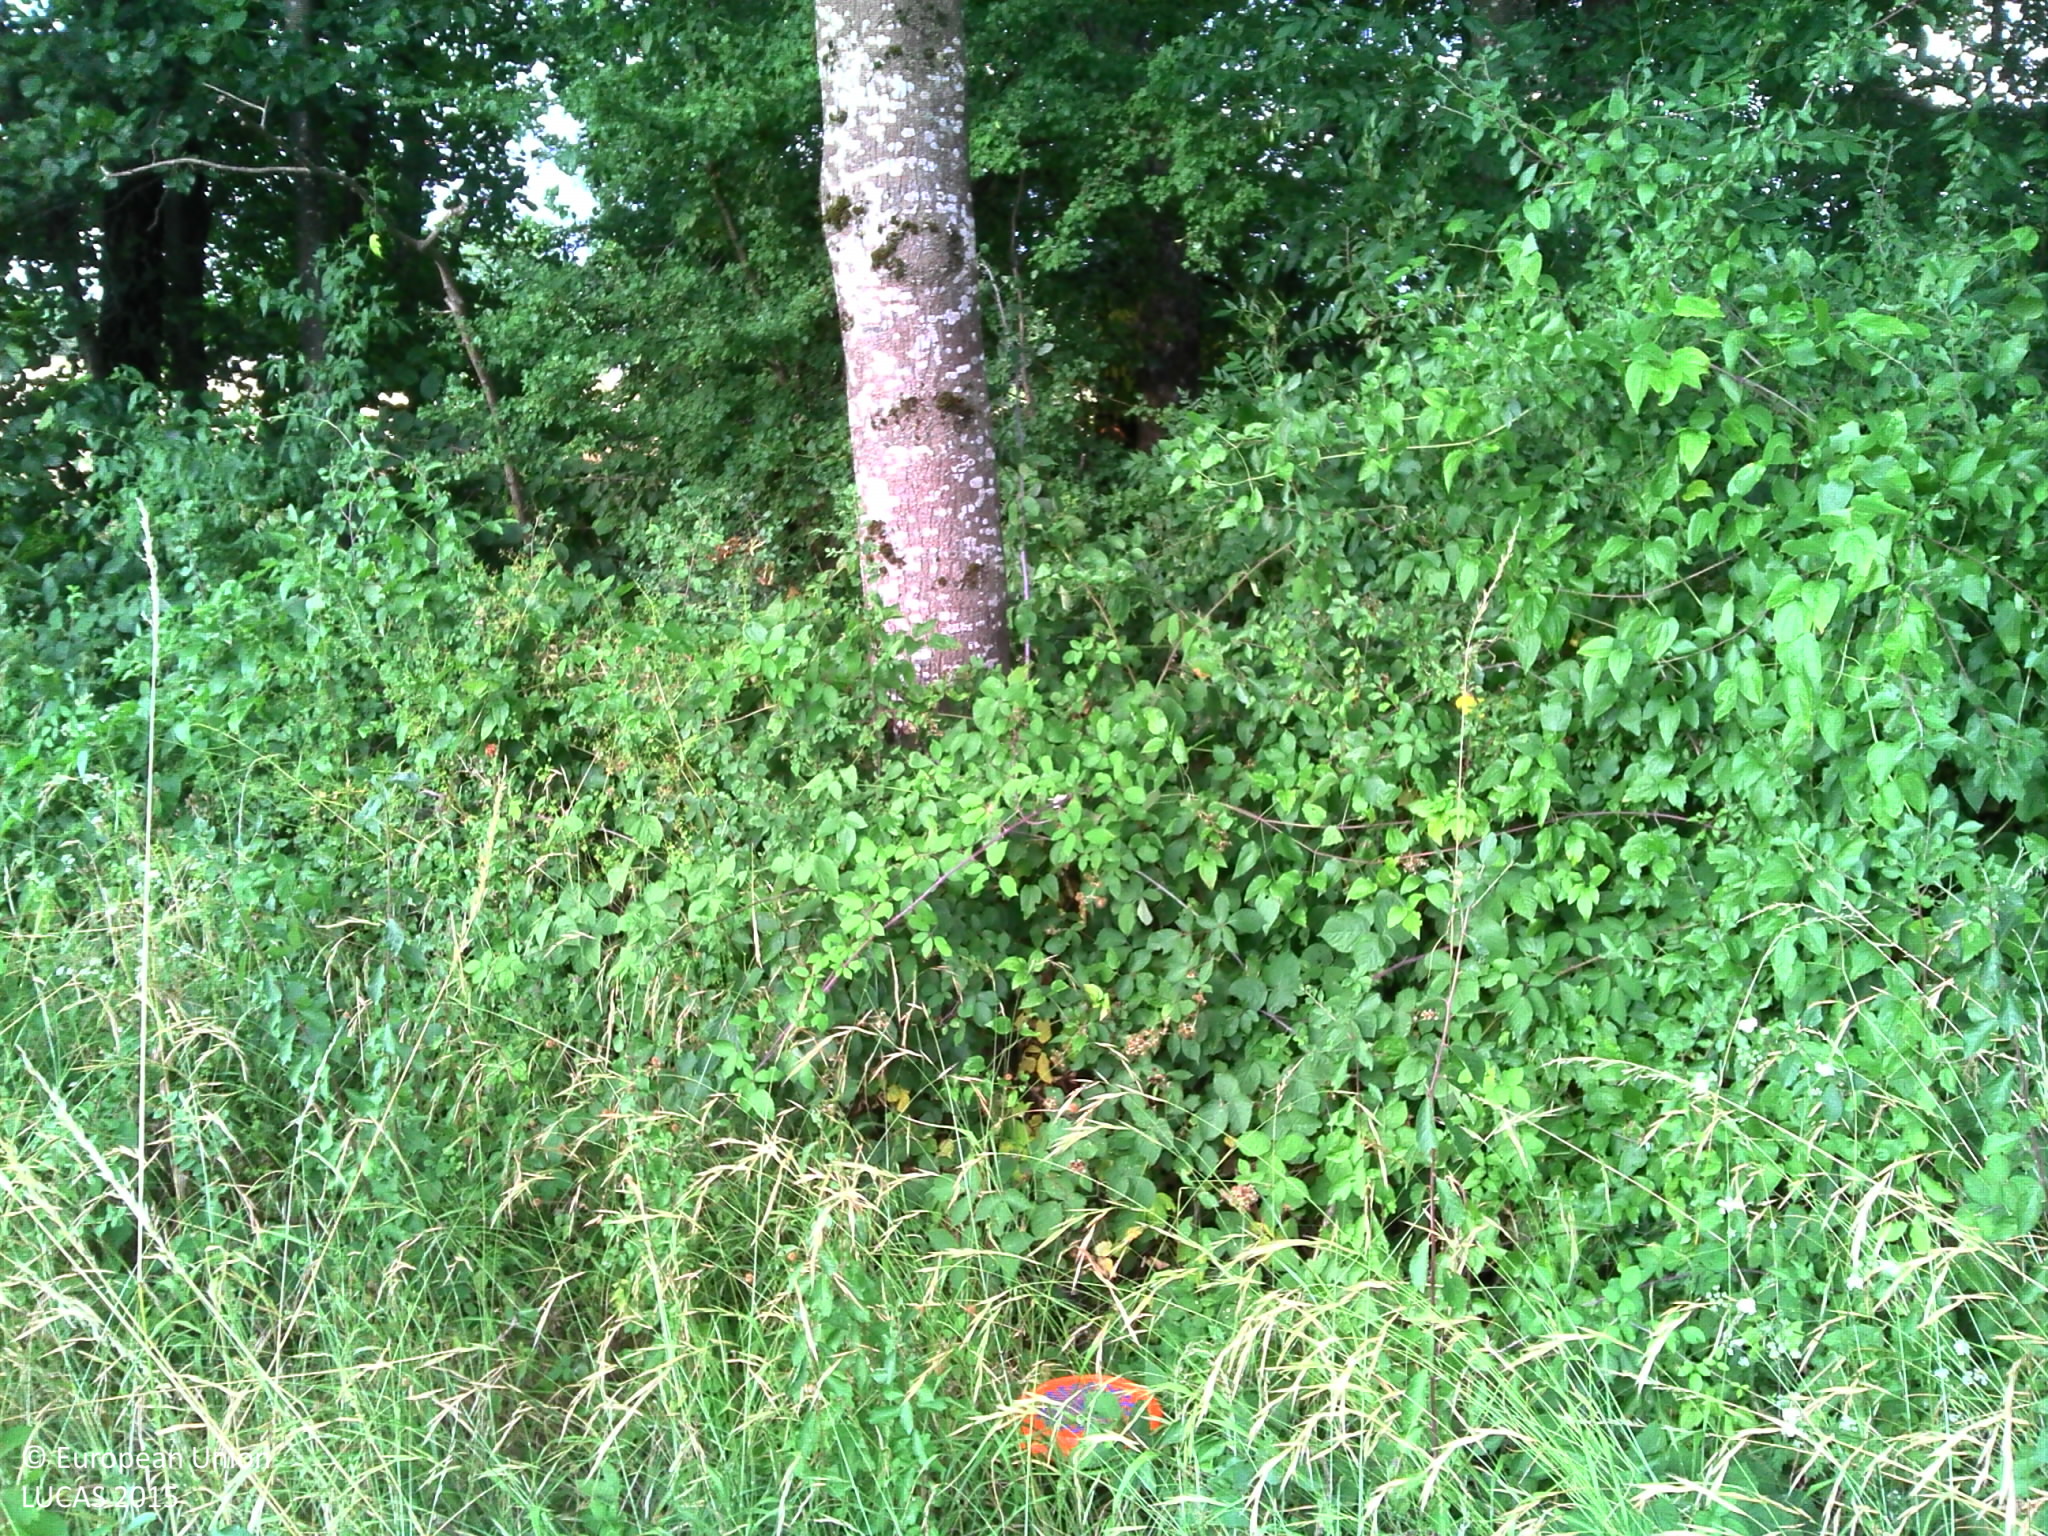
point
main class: Woodland
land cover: Broadleaved woodland
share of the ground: > 75 %
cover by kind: broadleaved forest trees 75 %, herbaceous plants 15 %, shrubs 10 %
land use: Semi-natural and natural areas not in use
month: July
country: FR
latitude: 45.4092
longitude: 5.1110
